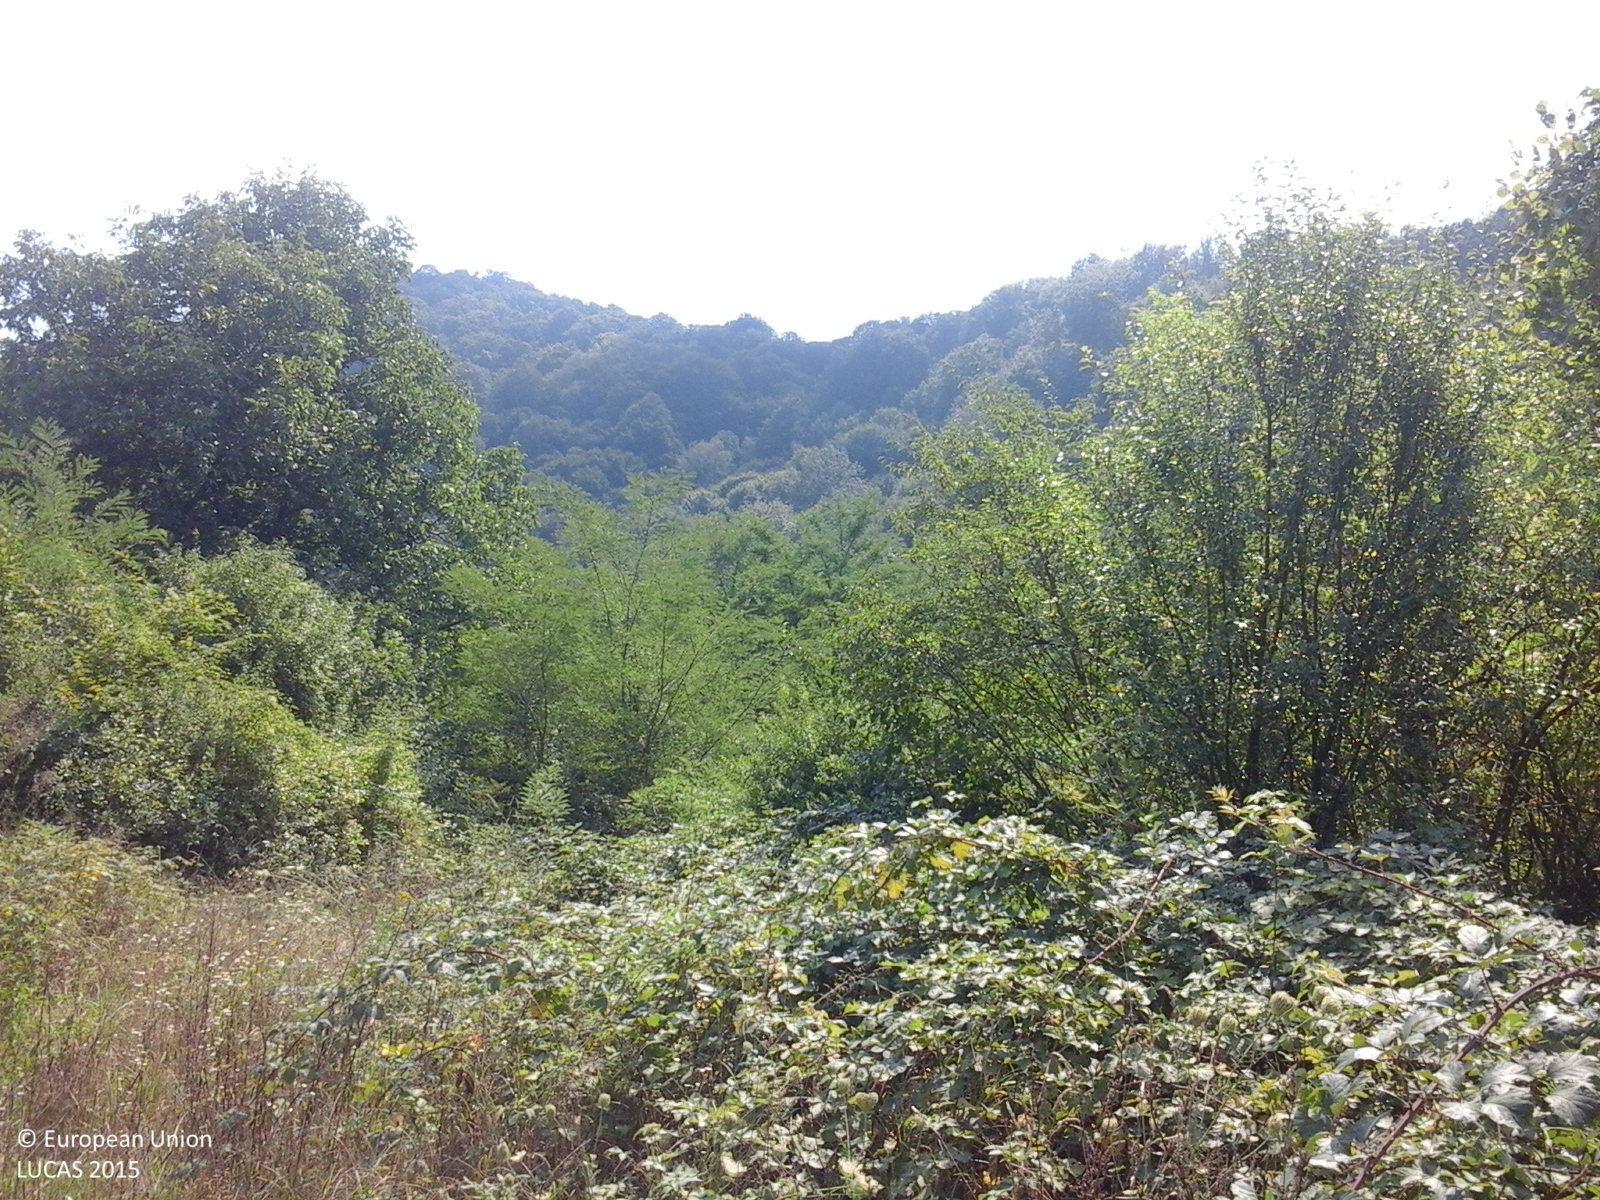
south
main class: Woodland
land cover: Broadleaved woodland
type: acidophilous oak and oak-birch forest
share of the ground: > 75 %
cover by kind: broadleaved forest trees 100 %
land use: Forestry
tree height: > 5 m
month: August
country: RO
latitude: 46.2772
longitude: 22.4427
